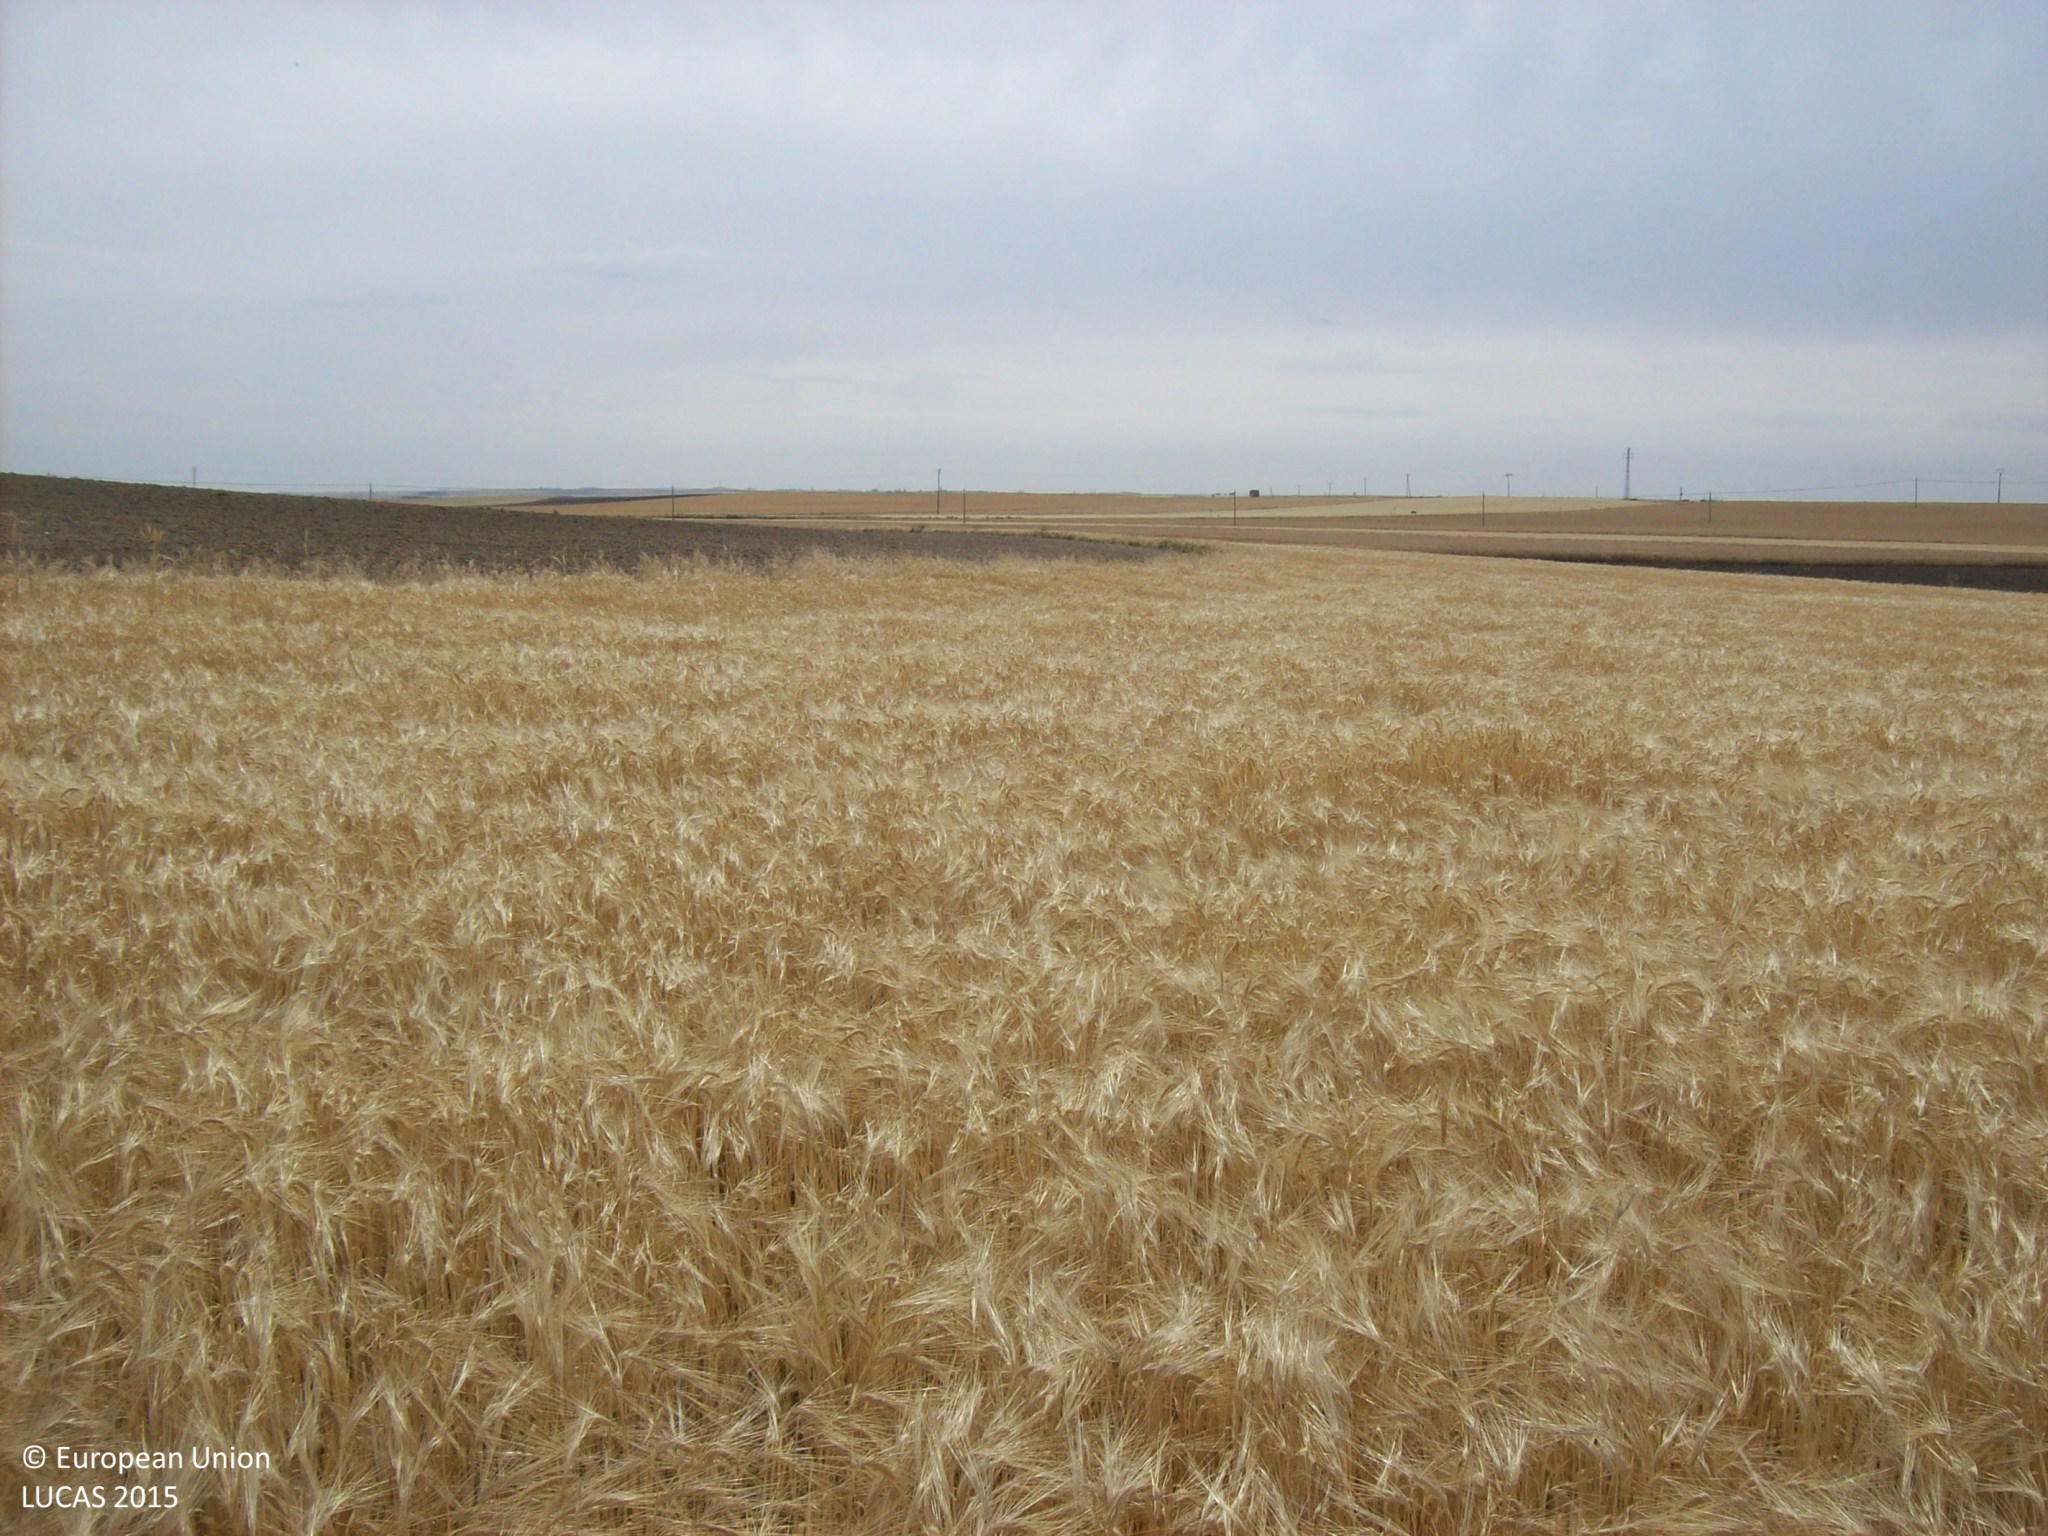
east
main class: Cropland
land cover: Barley
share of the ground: > 75 %
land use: Agriculture (excluding fallow land and kitchen gardens)
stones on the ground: < 10 %
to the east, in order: Barley; Grass margins; Other bare soil; Grass margins; Barley; Grass margins; Other bare soil; Barley
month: June
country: ES
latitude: 41.0389
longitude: -4.9704
